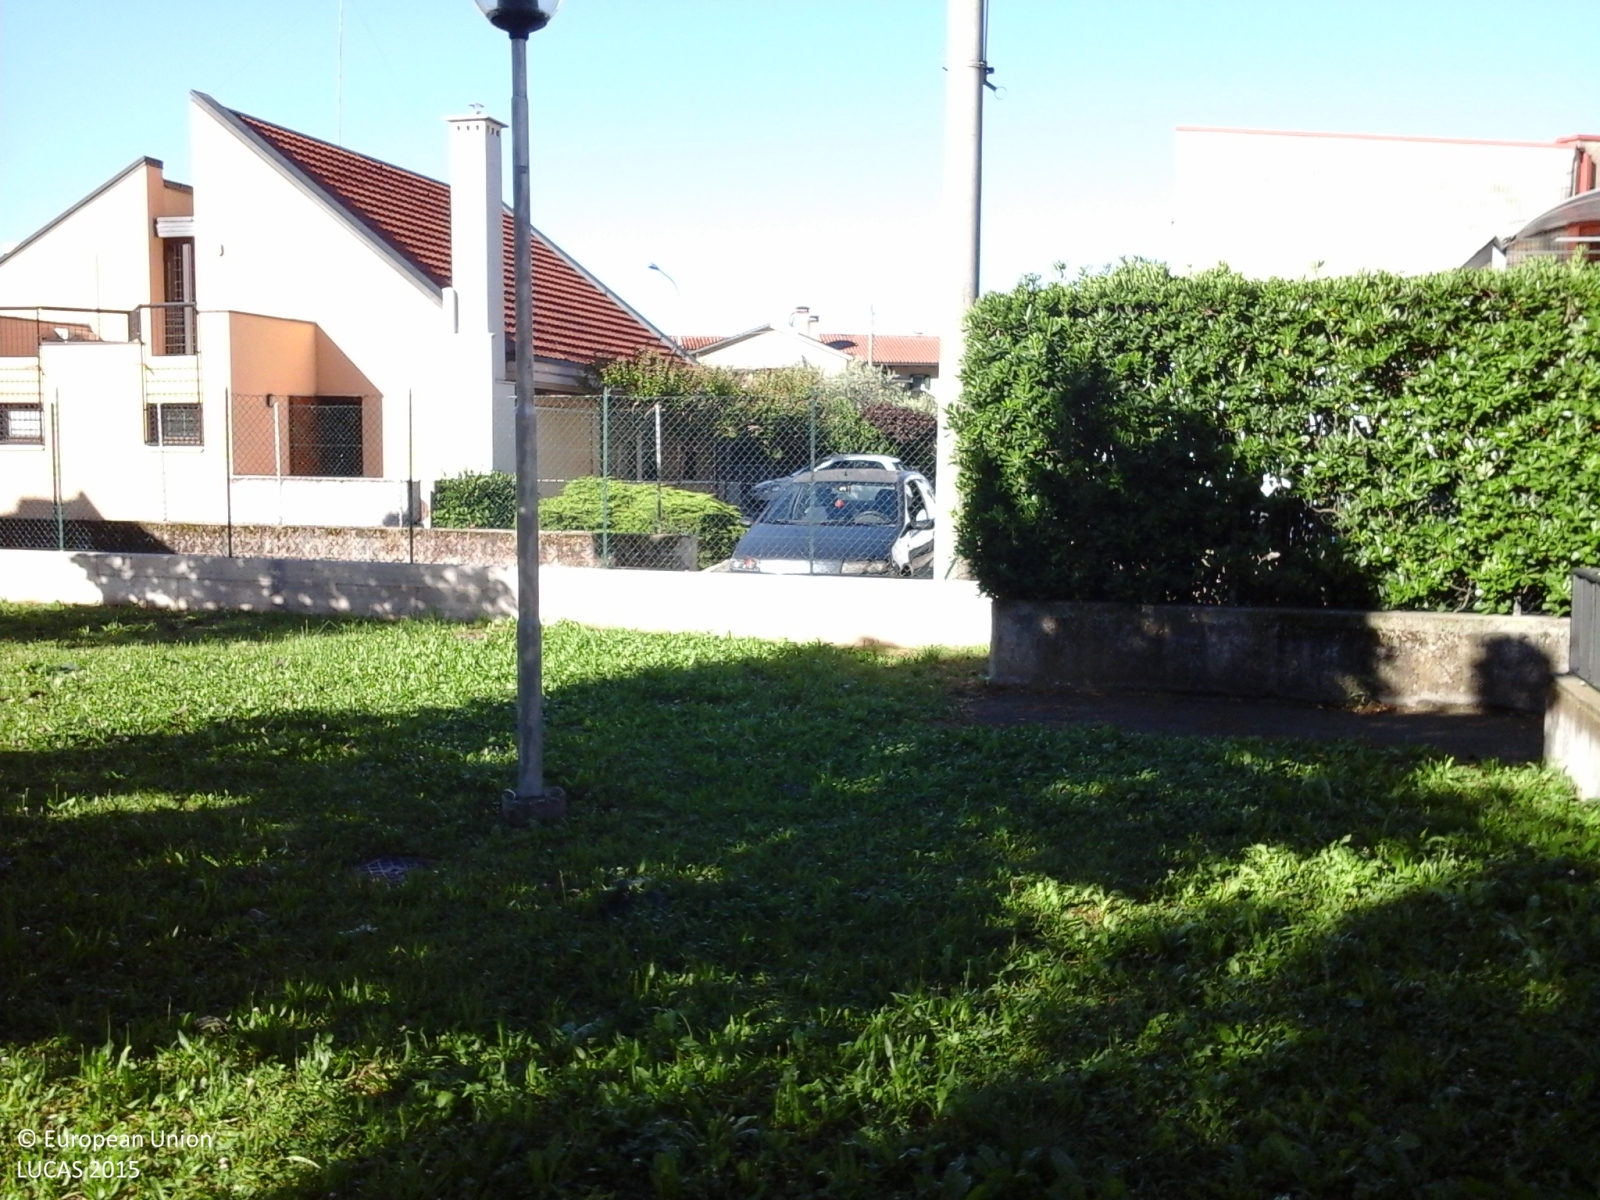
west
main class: Grassland
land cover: Grassland with sparse tree/shrub cover
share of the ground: > 75 %
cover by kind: herbaceous plants 95 %, broadleaved forest trees 5 %
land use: Amenities, museums, leisure
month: June
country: IT
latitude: 45.7966
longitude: 11.7342
